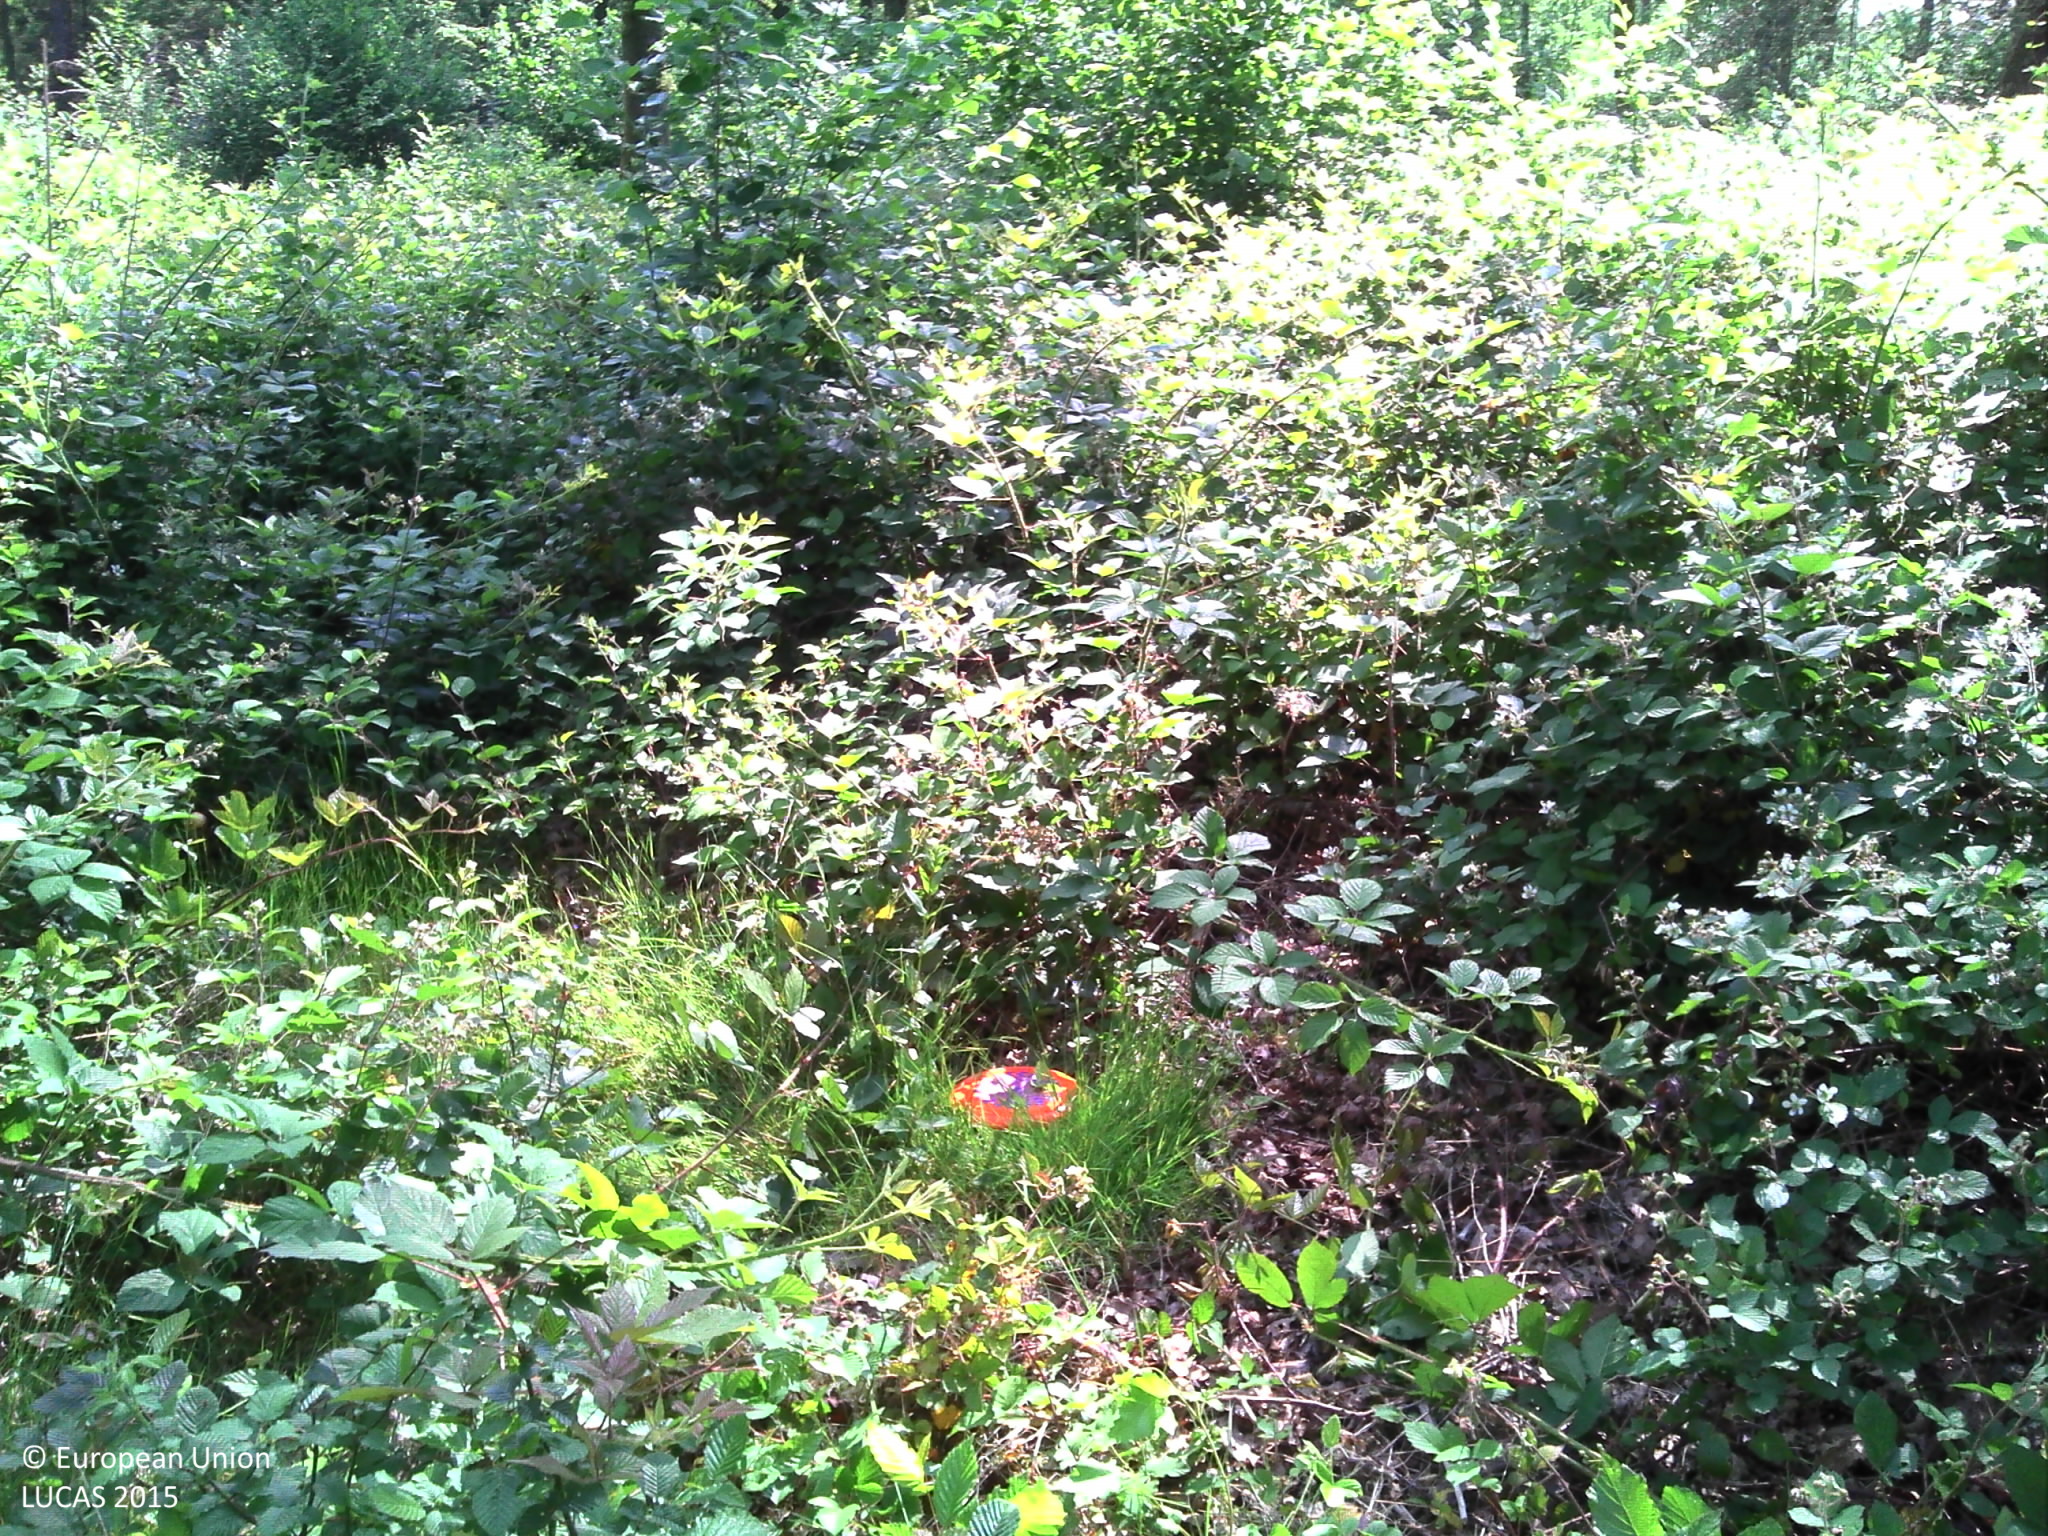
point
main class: Woodland
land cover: Broadleaved woodland
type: mesophytic deciduous forest
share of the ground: > 75 %
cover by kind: broadleaved forest trees 90 %, herbaceous plants 5 %, lichens and mosses 5 %
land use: Forestry
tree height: > 5 m
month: June
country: FR
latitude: 47.4266
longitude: 3.9660
